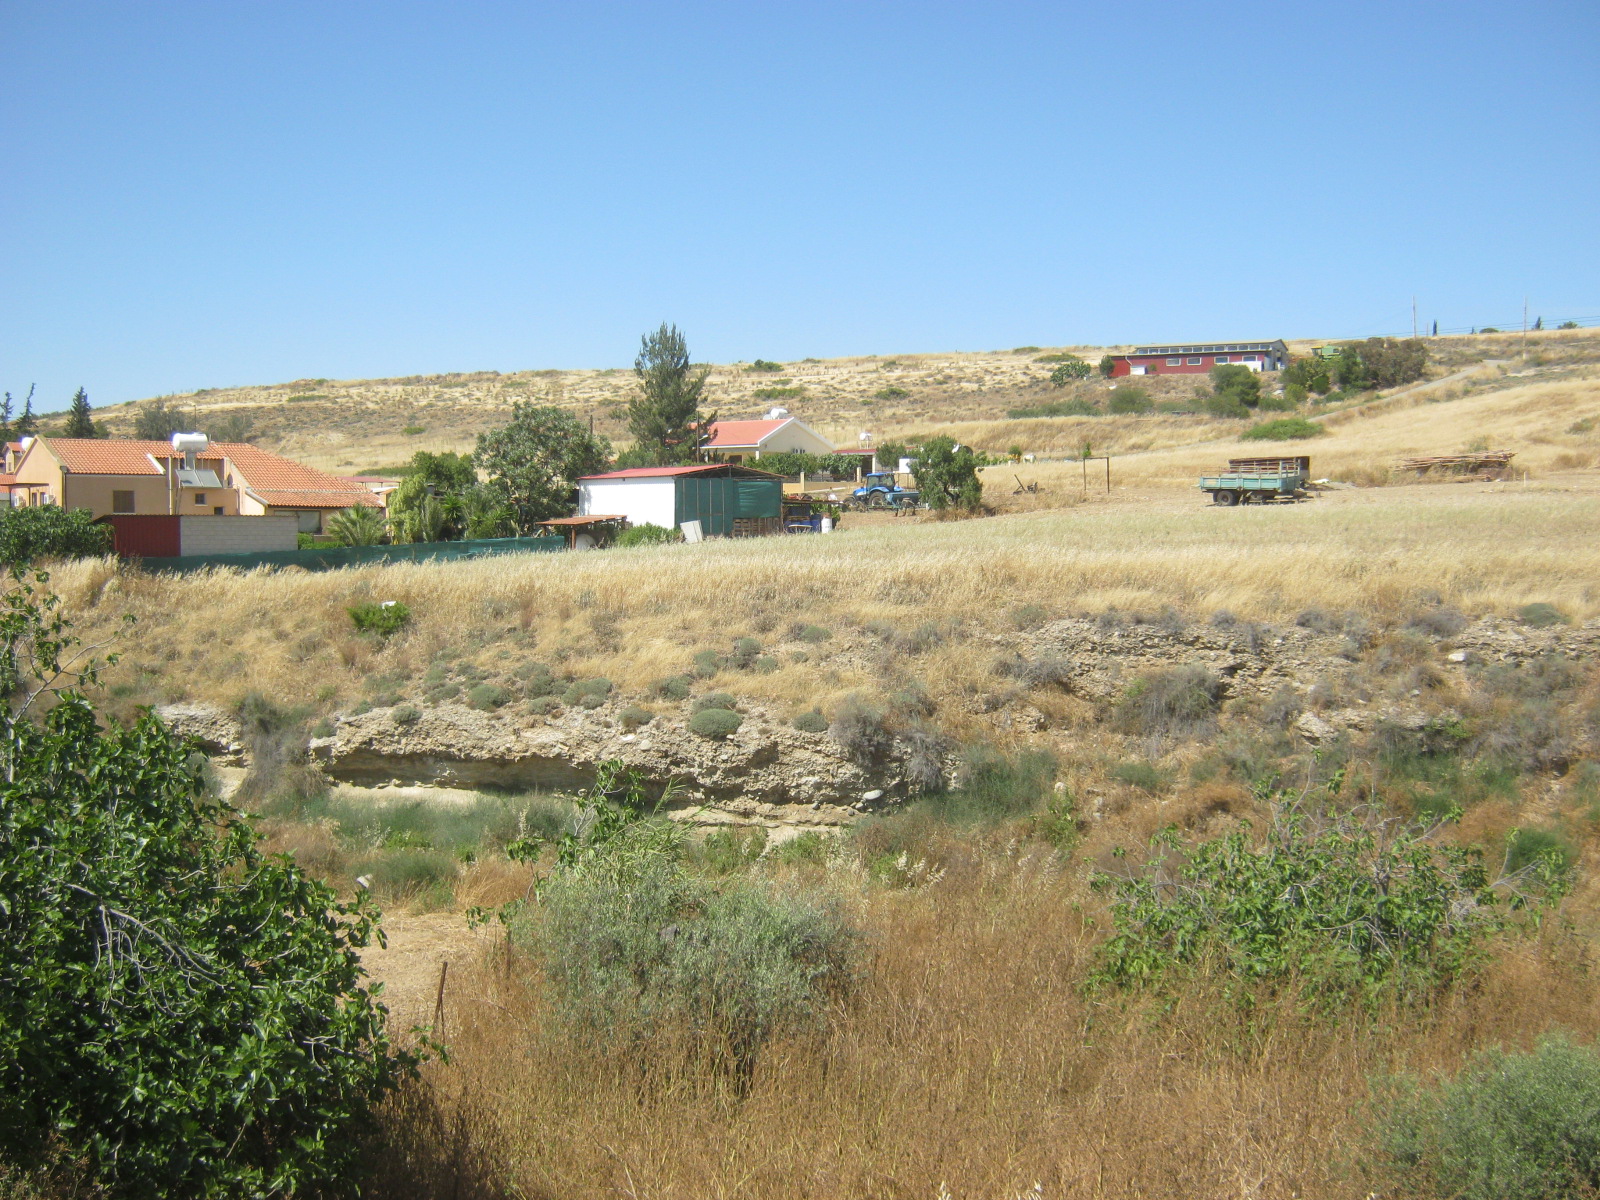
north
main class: Grassland
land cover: Grassland without tree/shrub cover
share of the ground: > 75 %
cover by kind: herbaceous plants 100 %
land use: Residential
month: May
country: CY
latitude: 35.1049
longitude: 33.0307
